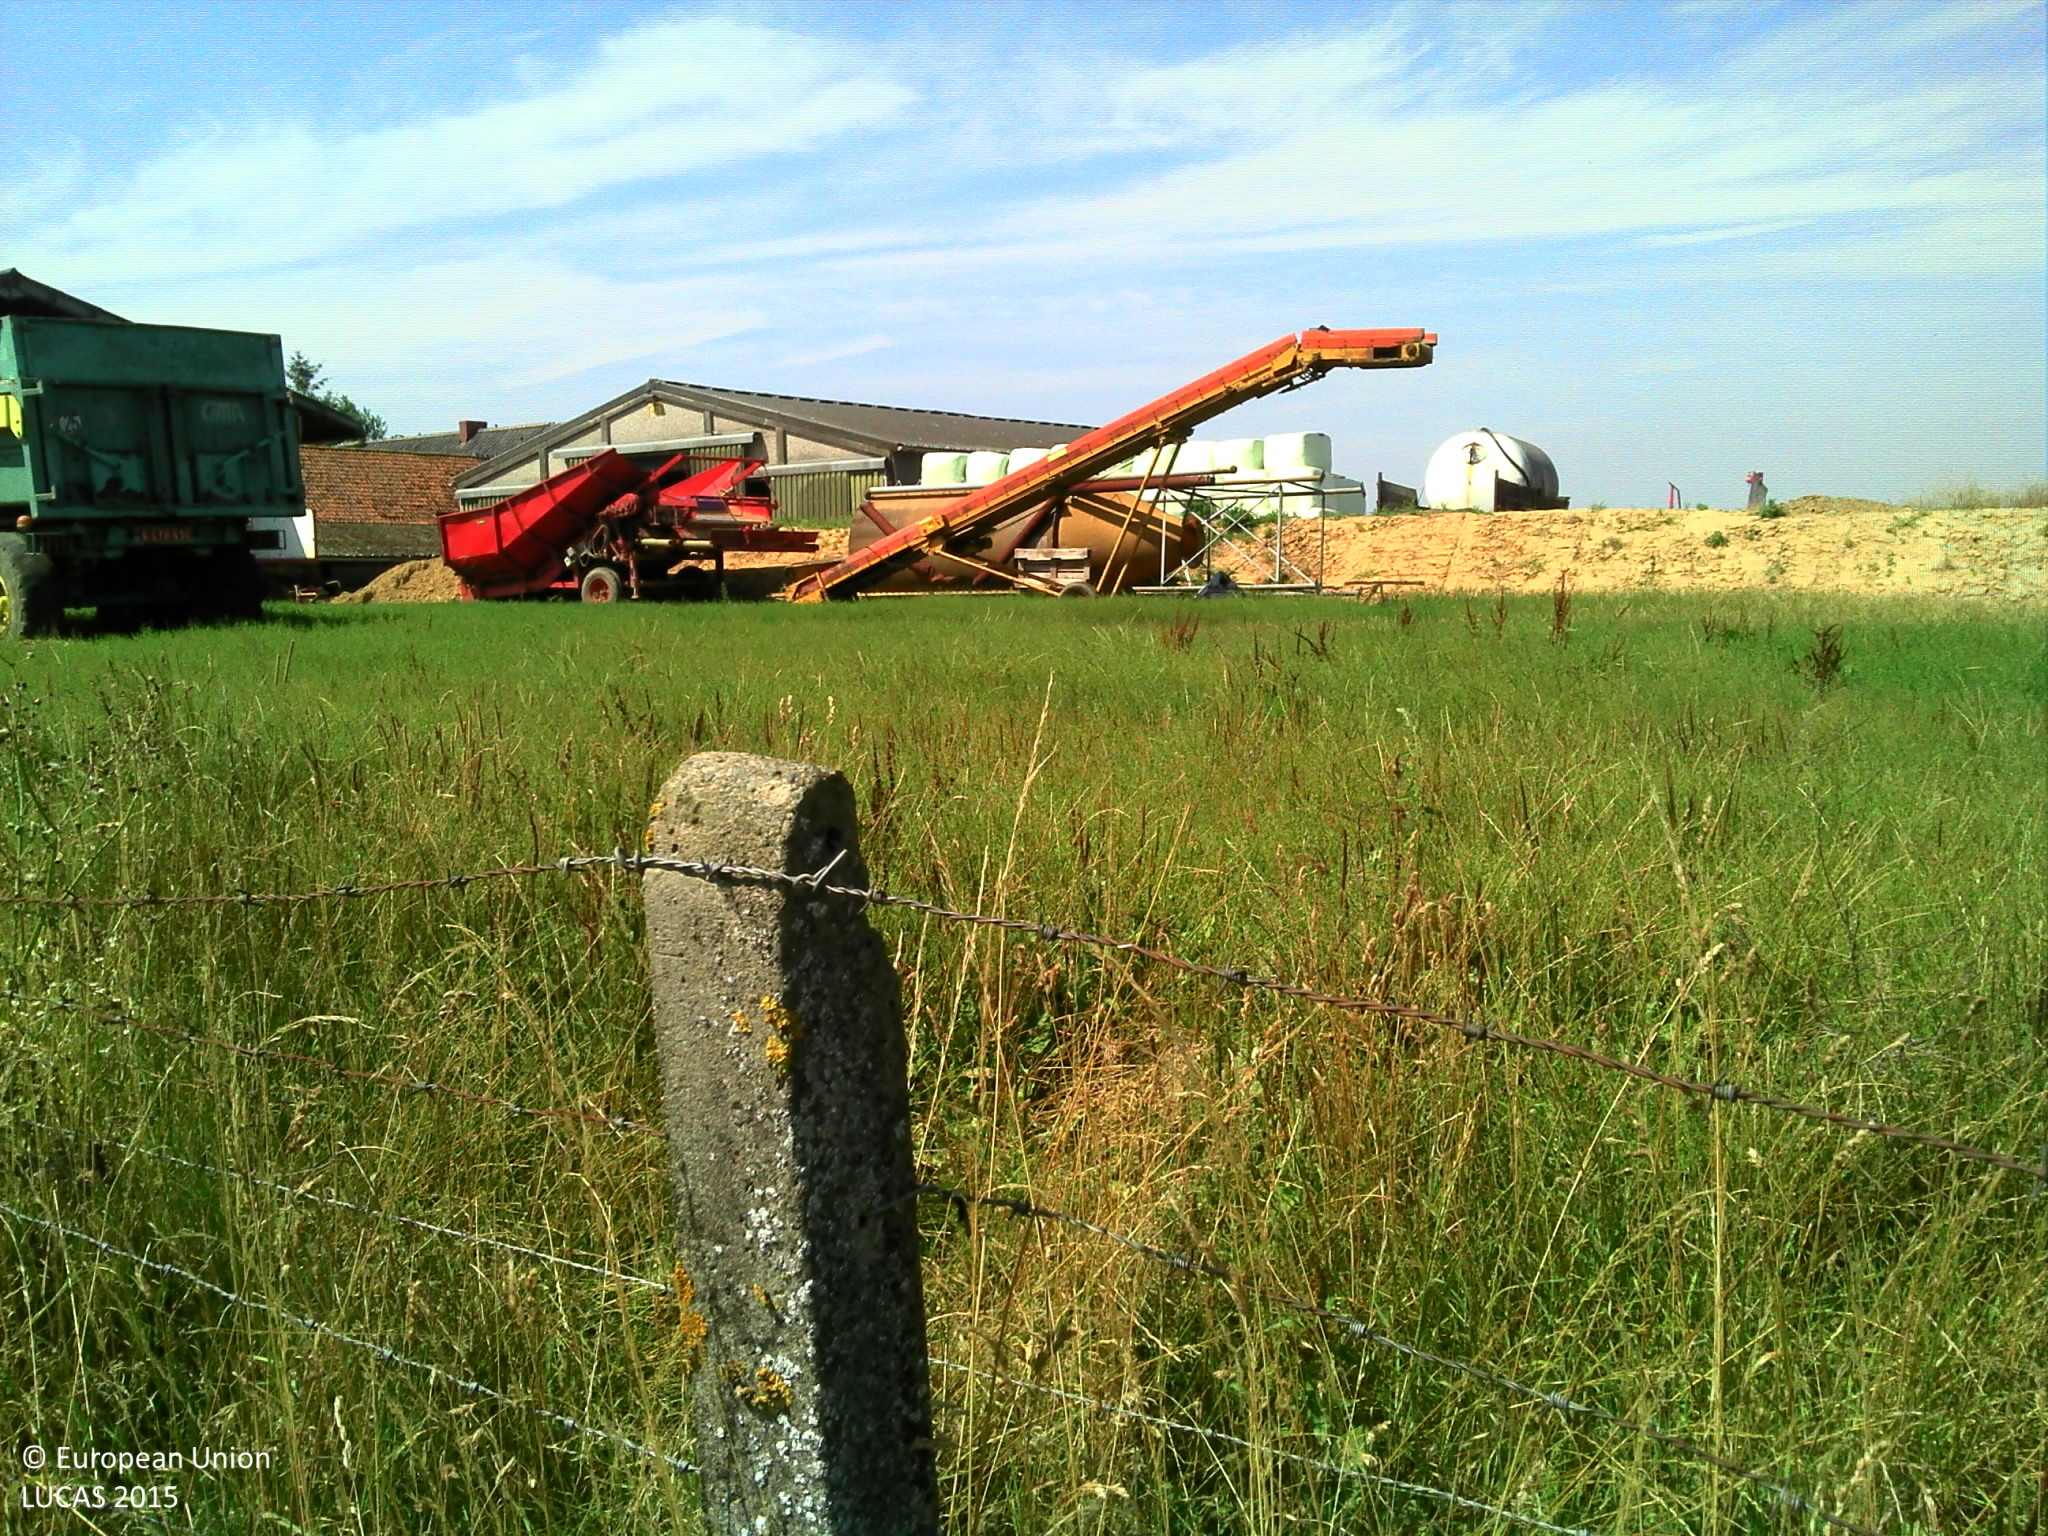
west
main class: Grassland
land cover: Grassland without tree/shrub cover
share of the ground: > 75 %
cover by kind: herbaceous plants 100 %
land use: Agriculture (excluding fallow land and kitchen gardens)
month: August
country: BE
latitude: 50.6893
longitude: 3.9213
